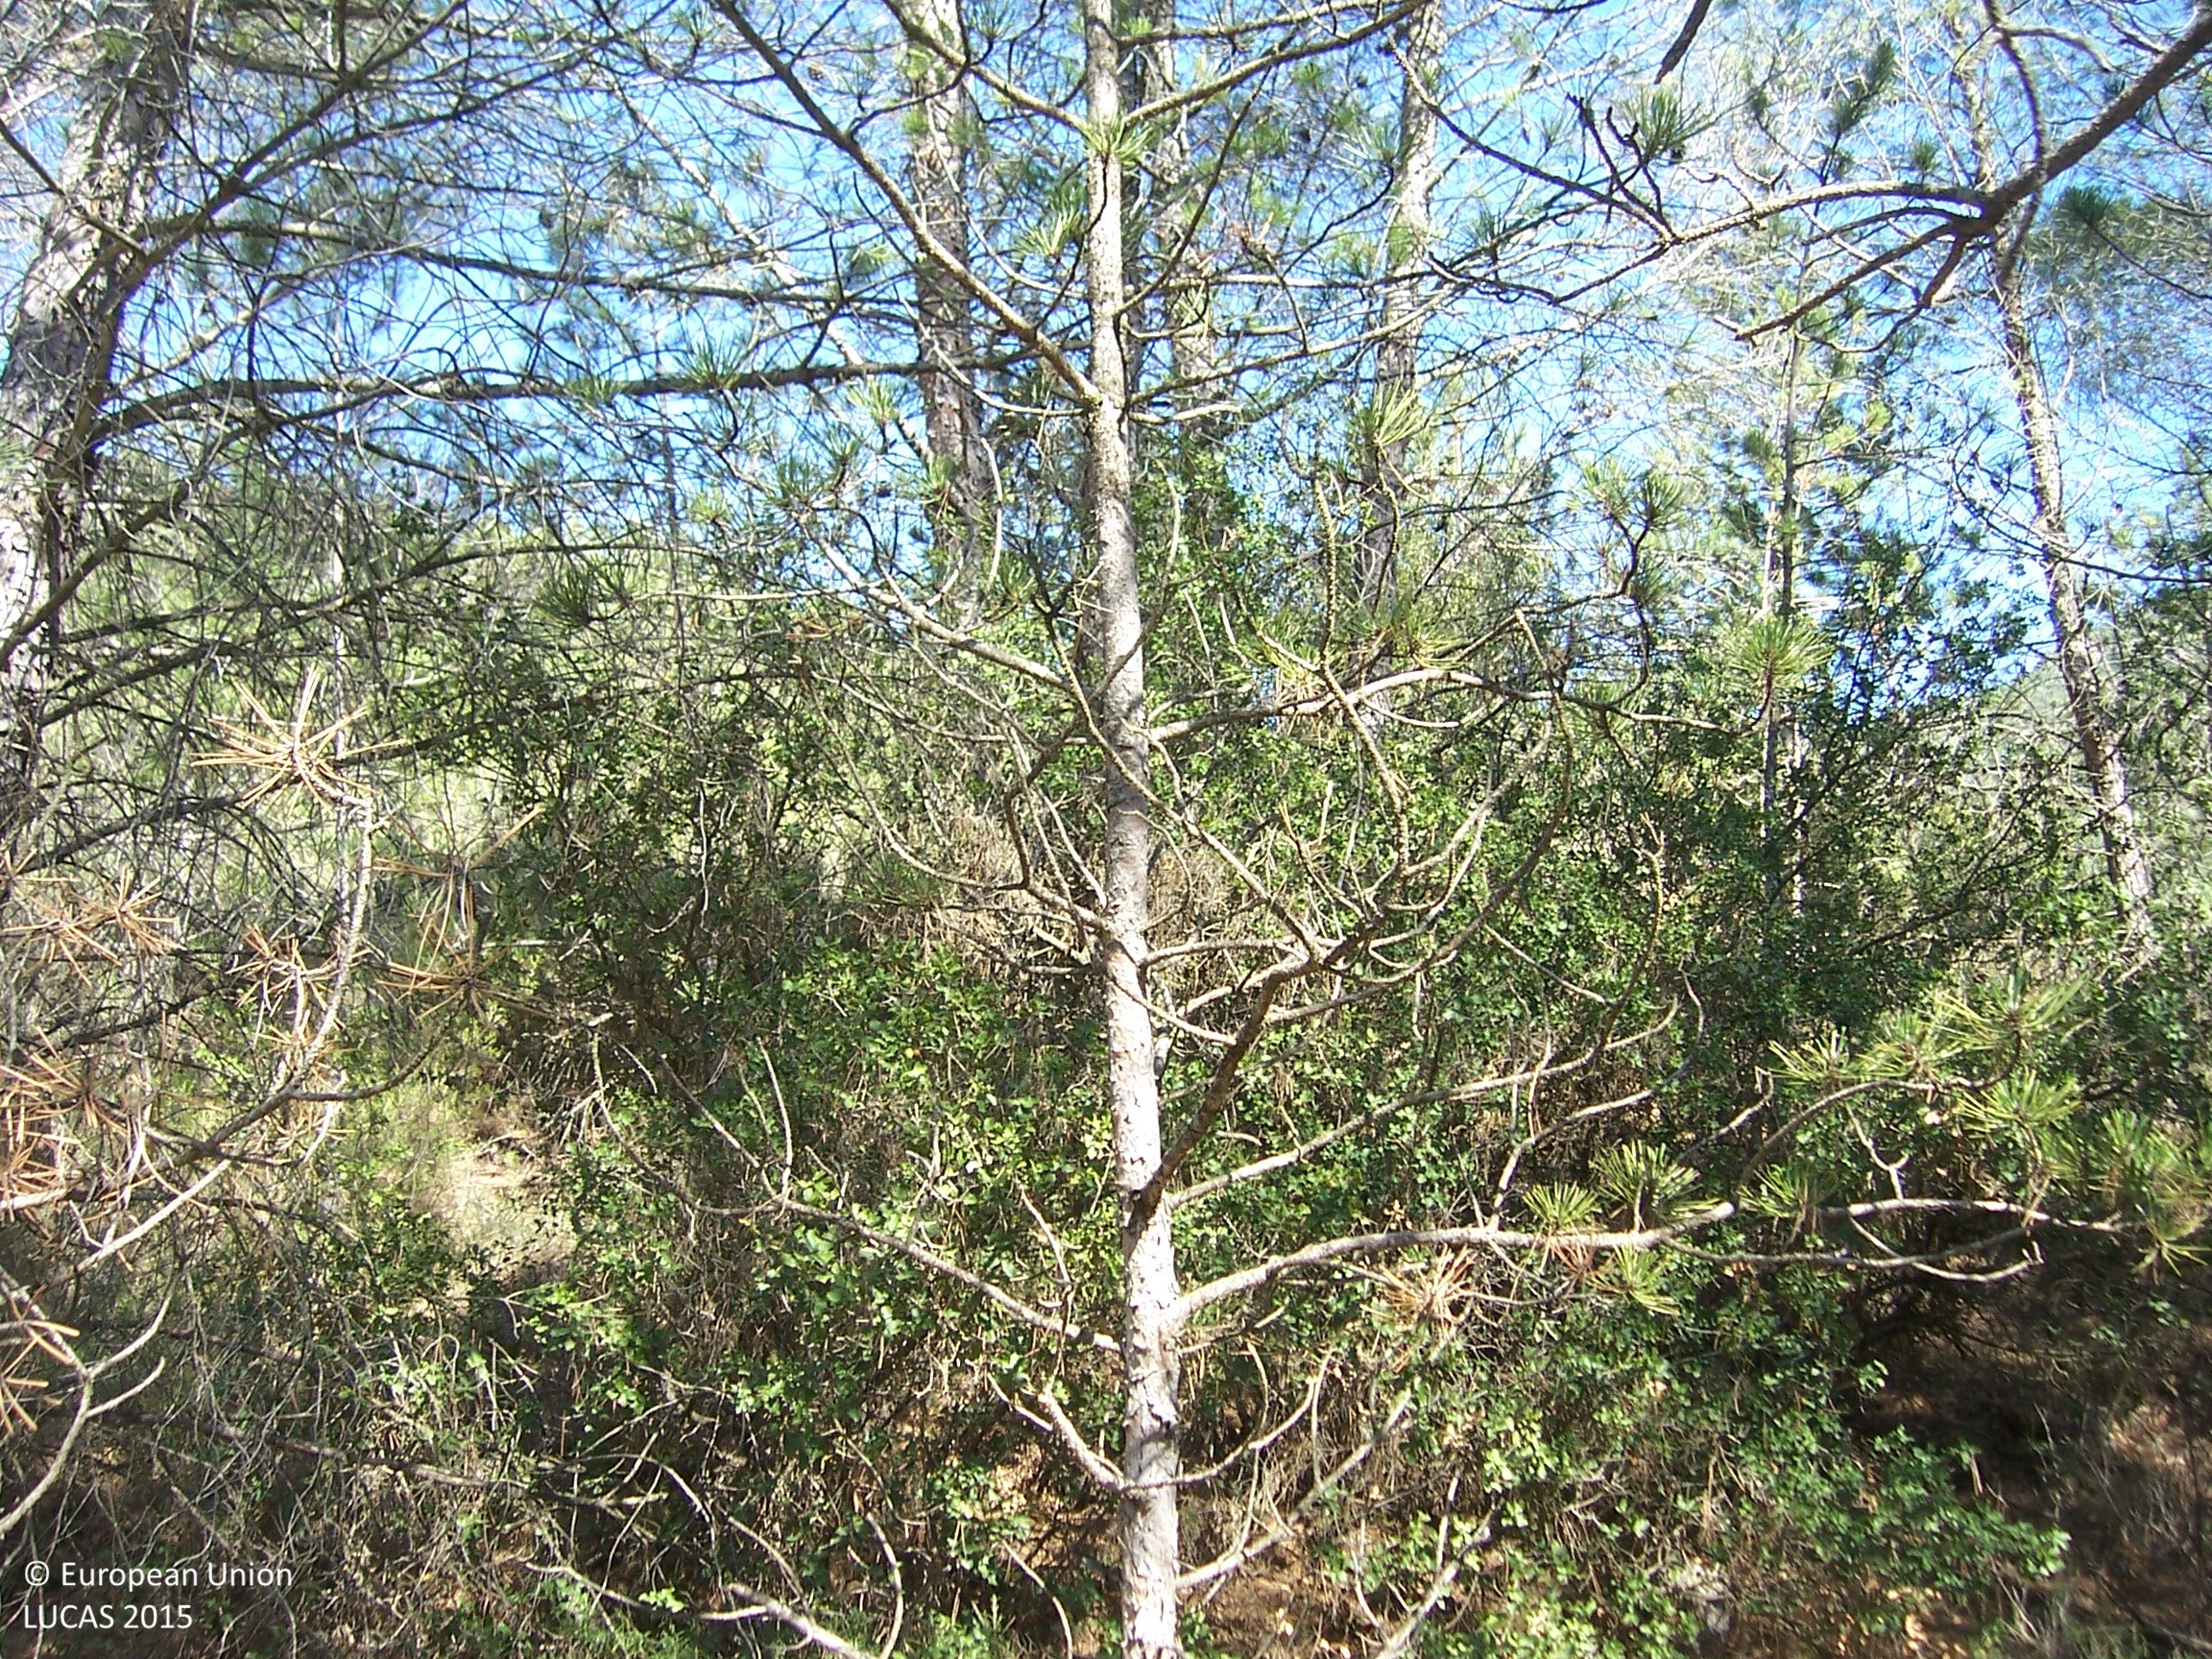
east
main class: Woodland
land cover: Pine dominated coniferous woodland
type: coniferous forest of the mediterranean region
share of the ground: 50 - 75 %
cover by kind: coniferous forest trees 50 %, shrubs 30 %, unconsolidated bare surface 15 %, broadleaved forest trees 5 %
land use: Semi-natural and natural areas not in use
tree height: > 5 m
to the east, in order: Pine dominated coniferous woodland; Shrubland with sparse tree cover; Pine dominated coniferous woodland
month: August
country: ES
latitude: 41.9625
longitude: 0.6099
